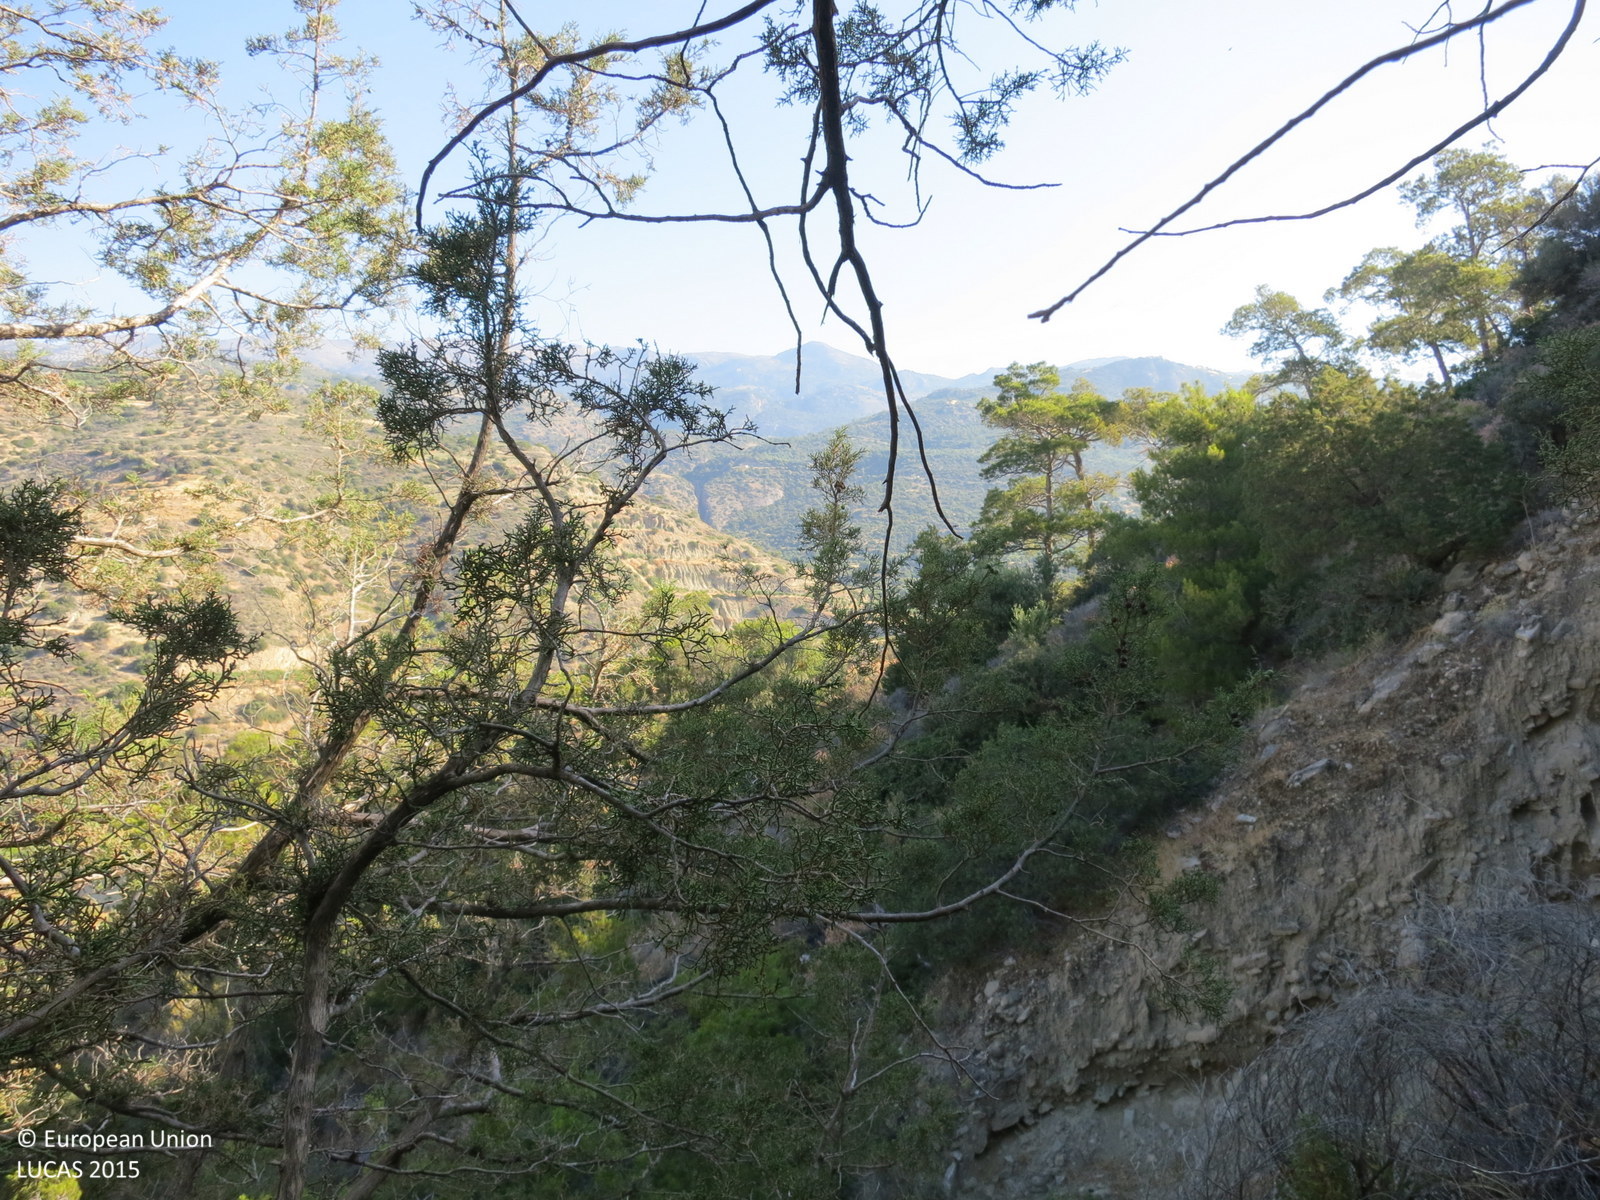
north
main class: Woodland
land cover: Pine dominated mixed woodland
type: coniferous forest of the mediterranean region
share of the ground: > 75 %
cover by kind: coniferous forest trees 50 %, broadleaved forest trees 25 %, shrubs 10 %, herbaceous plants 5 %
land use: Semi-natural and natural areas not in use
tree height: > 5 m
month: June
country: GR
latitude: 34.9940
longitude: 25.4929
